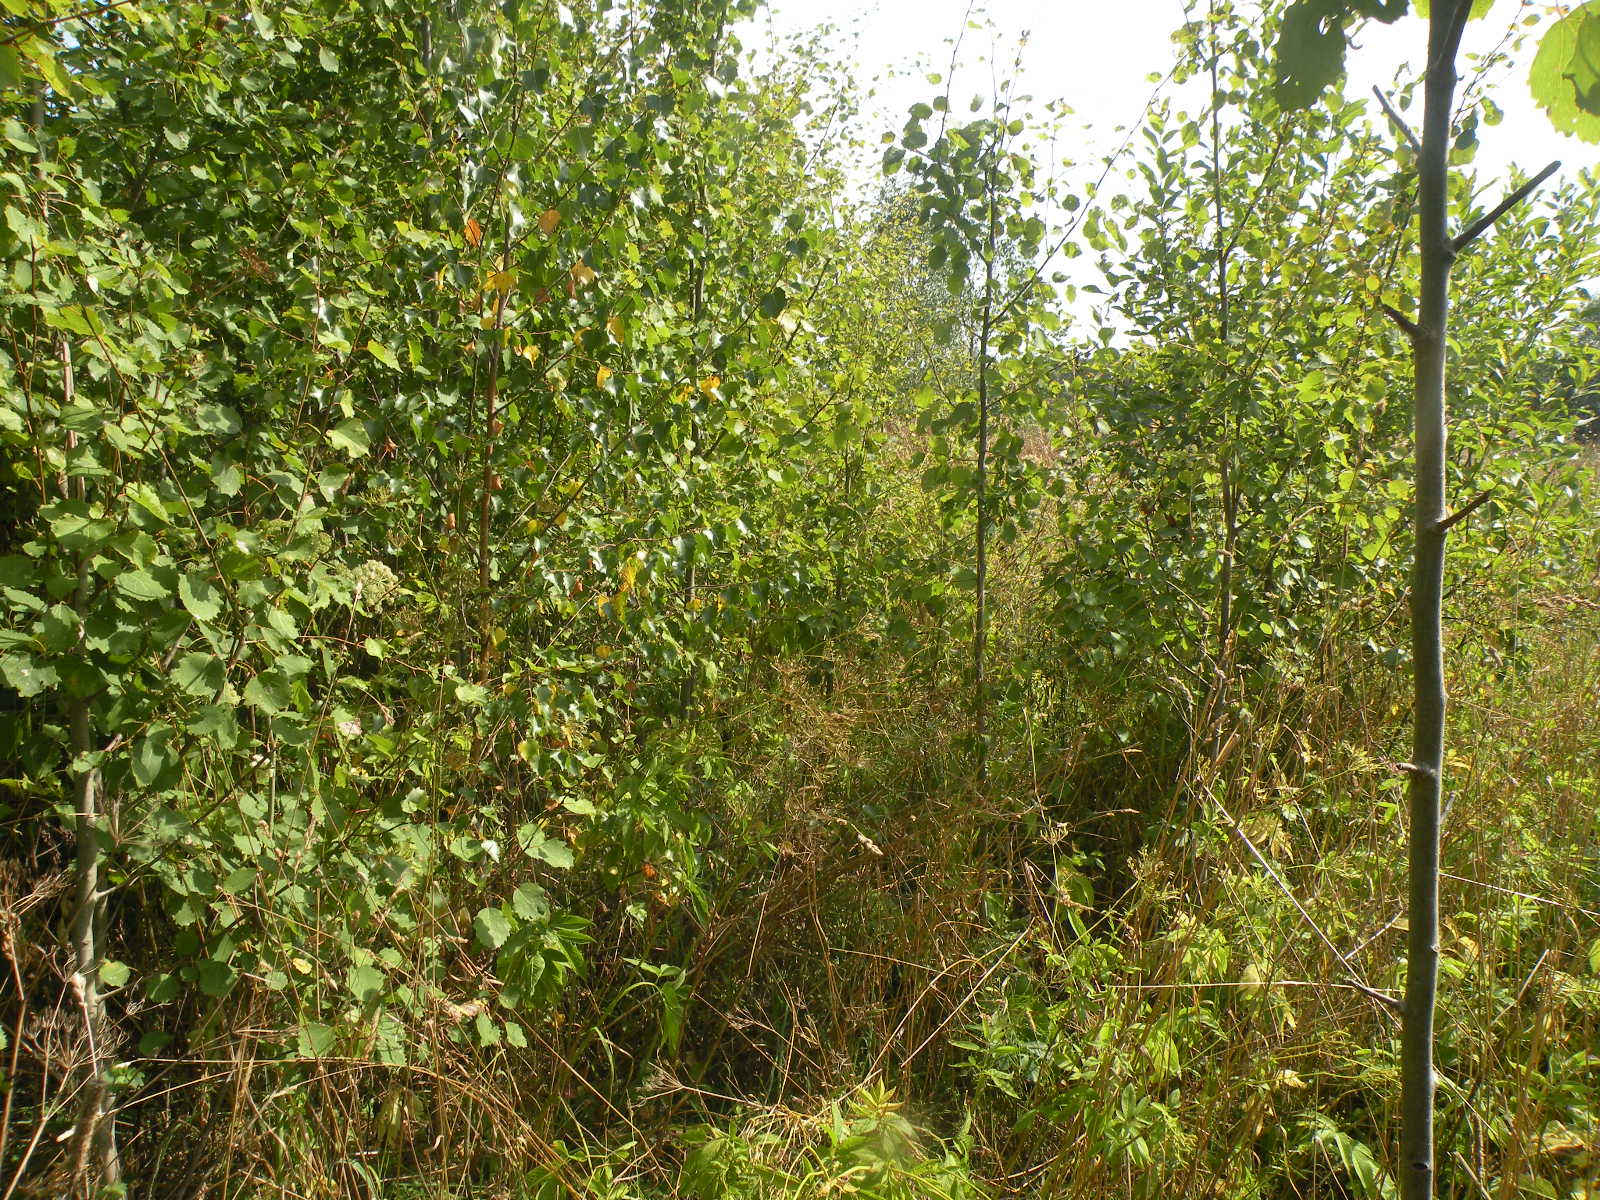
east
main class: Woodland
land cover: Broadleaved woodland
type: non-riverine alder, birch or aspen forest
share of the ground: > 75 %
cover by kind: broadleaved forest trees 75 %, herbaceous plants 15 %, shrubs 10 %
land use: Forestry
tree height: > 5 m
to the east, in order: Broadleaved woodland; Grassland without tree/shrub cover; Common wheat
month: August
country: LV
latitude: 55.8689
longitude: 26.1697
